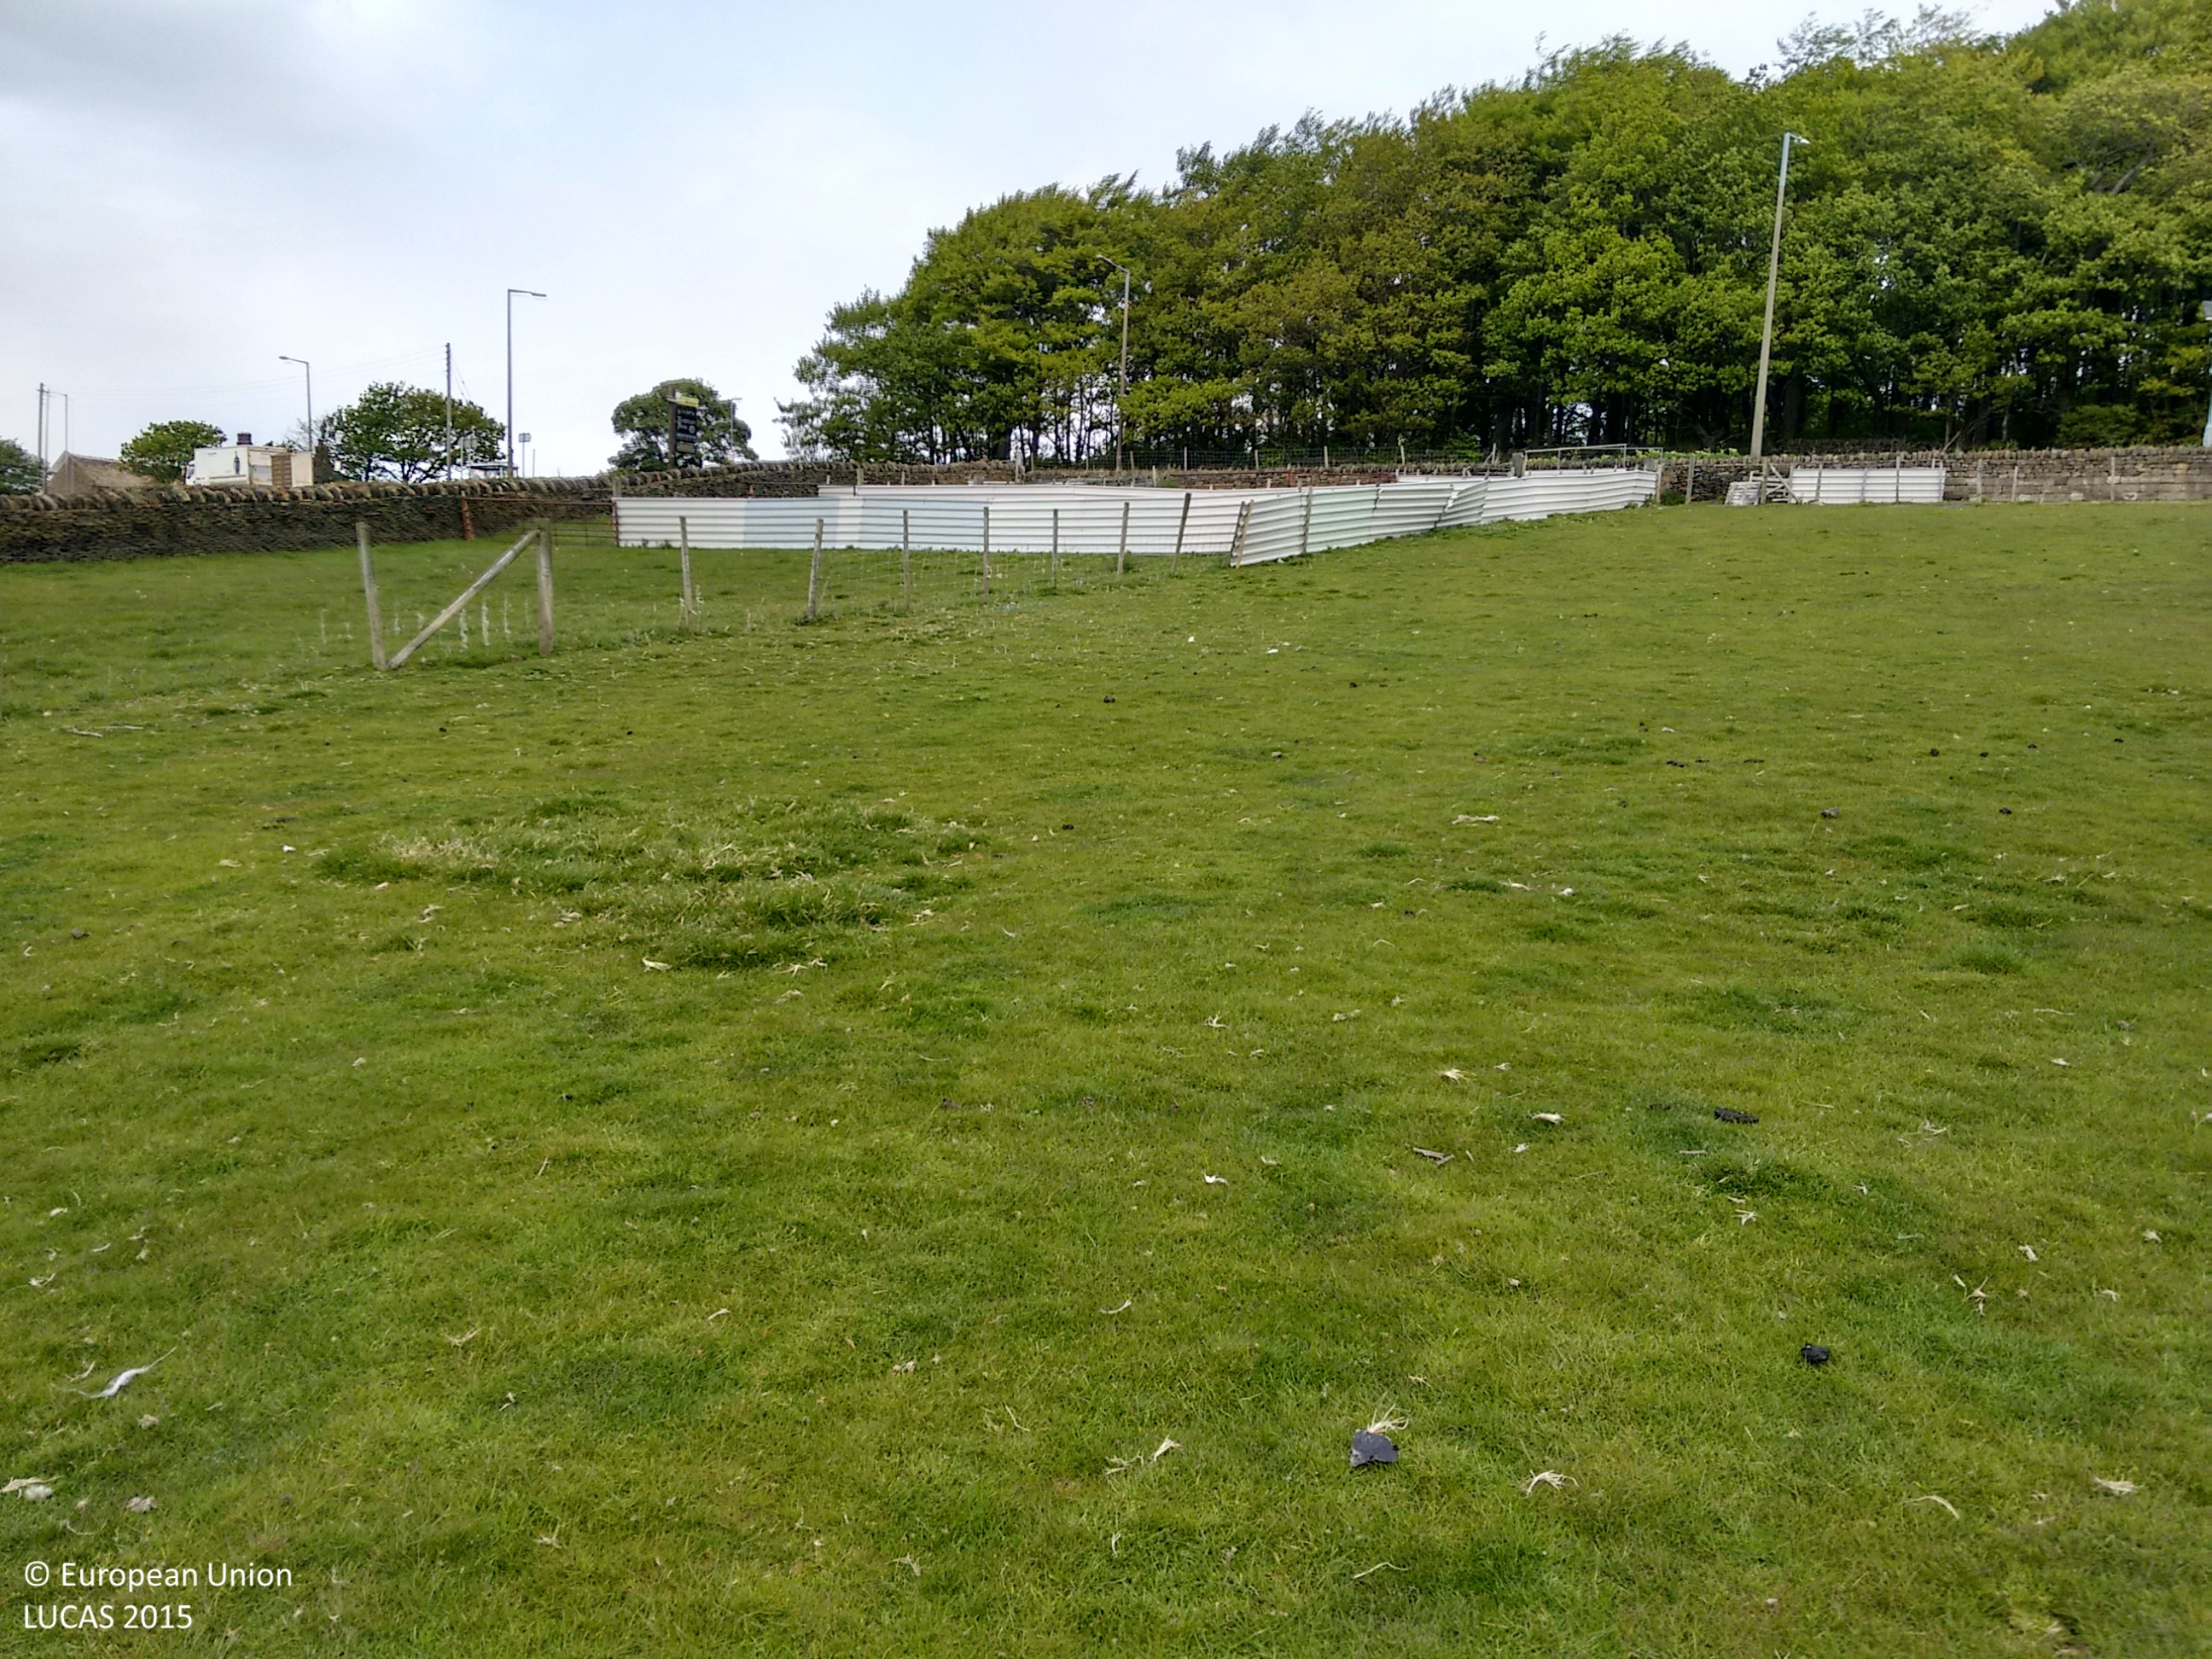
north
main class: Grassland
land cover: Grassland without tree/shrub cover
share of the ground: > 75 %
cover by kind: herbaceous plants 100 %
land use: Agriculture (excluding fallow land and kitchen gardens)
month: May
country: GB
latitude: 53.5009
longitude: -1.5537
